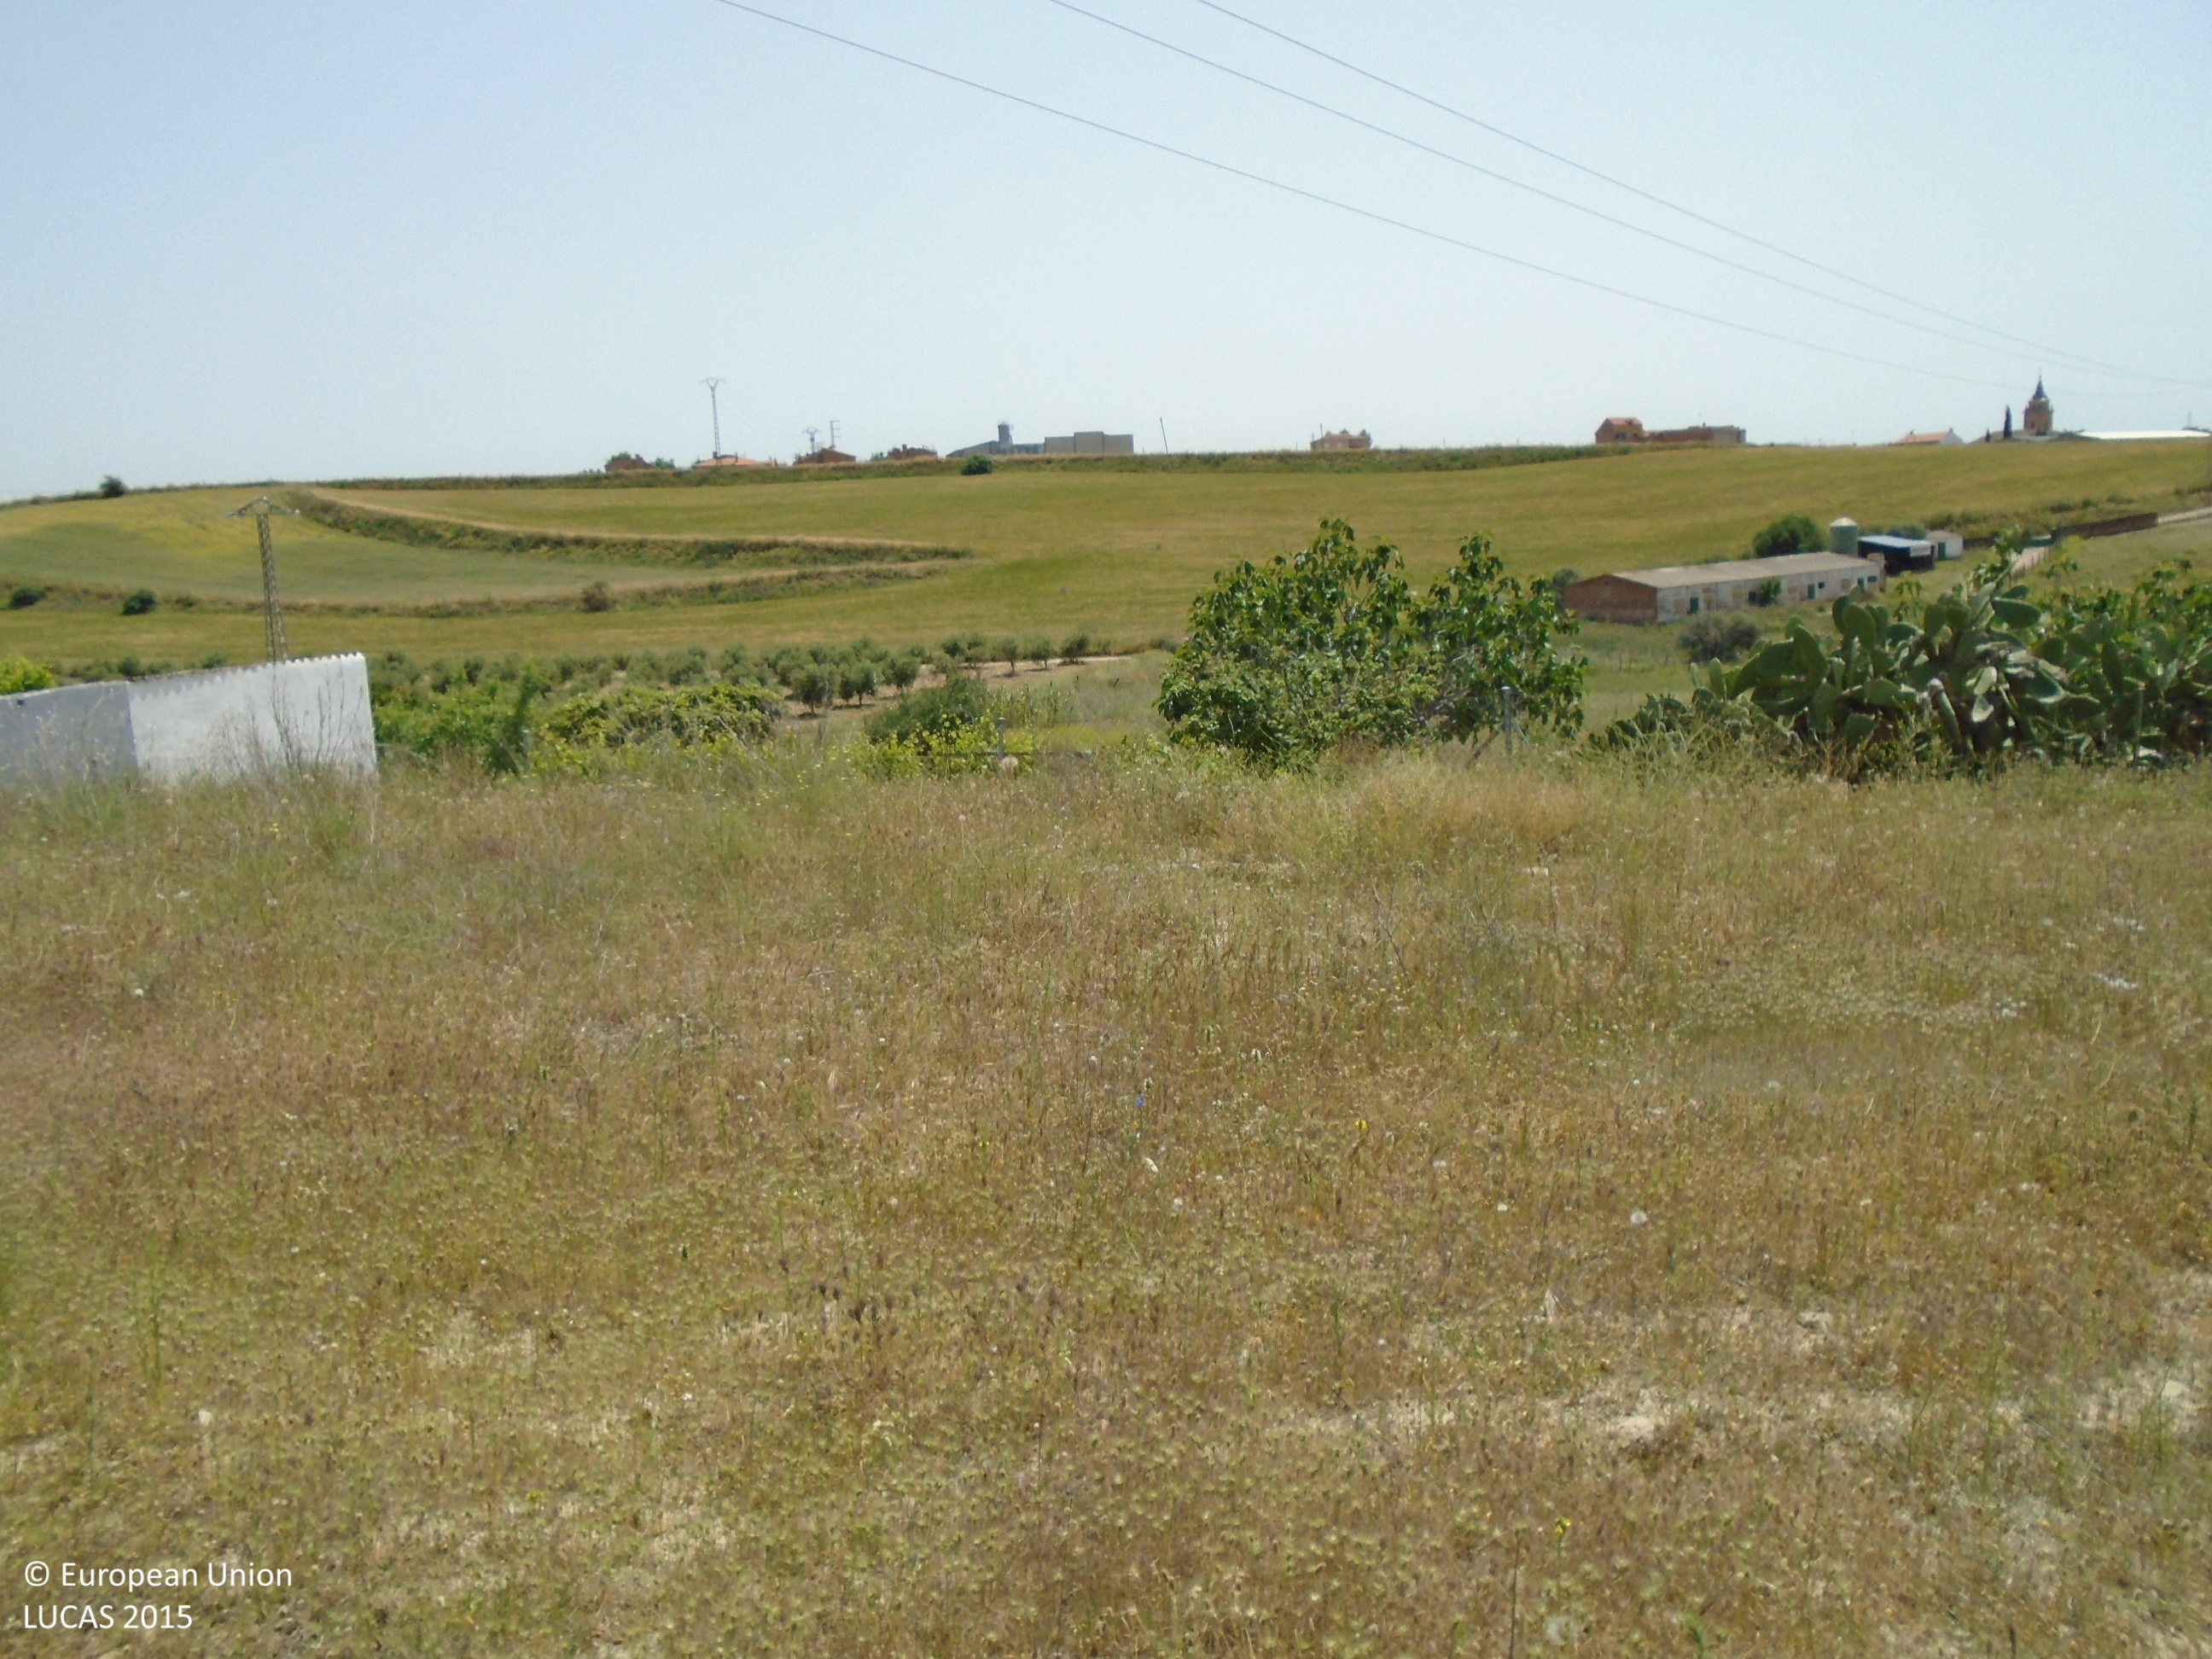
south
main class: Cropland
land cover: Vineyards
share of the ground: 10 - 25 %
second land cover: Other bare soil
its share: > 75 %
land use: Agriculture (excluding fallow land and kitchen gardens)
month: May
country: ES
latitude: 39.7885
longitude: -4.6270
